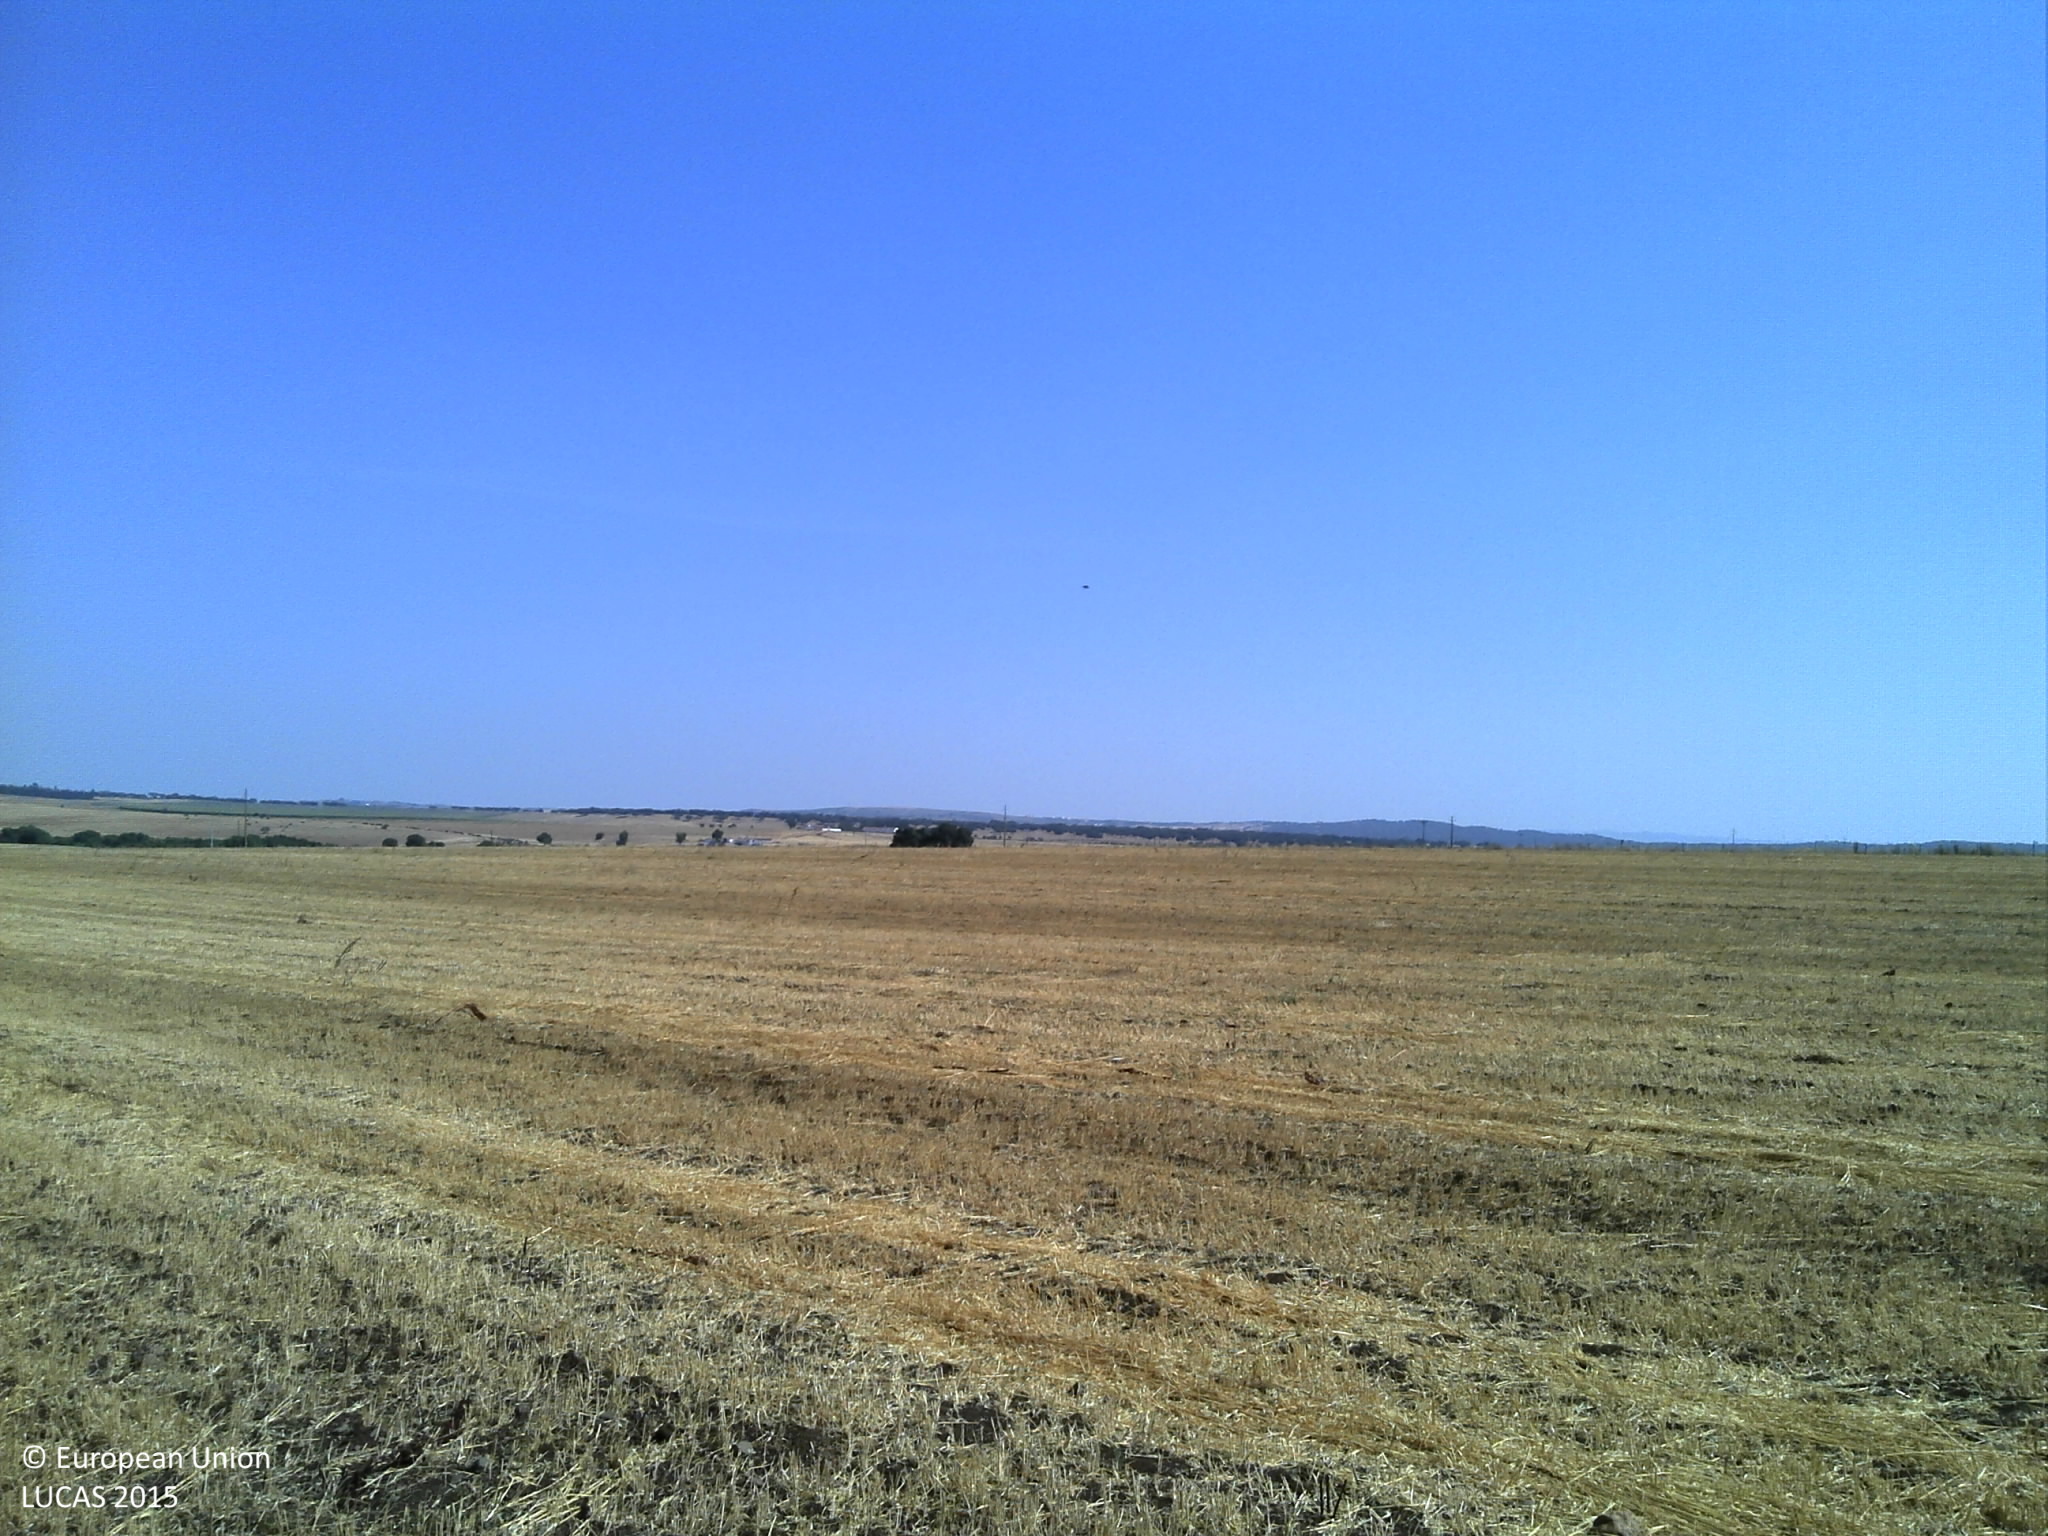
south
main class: Cropland
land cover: Oats
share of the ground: 10 - 25 %
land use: Agriculture (excluding fallow land and kitchen gardens)
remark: Harvested field
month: July
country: PT
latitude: 38.5740
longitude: -7.6759
